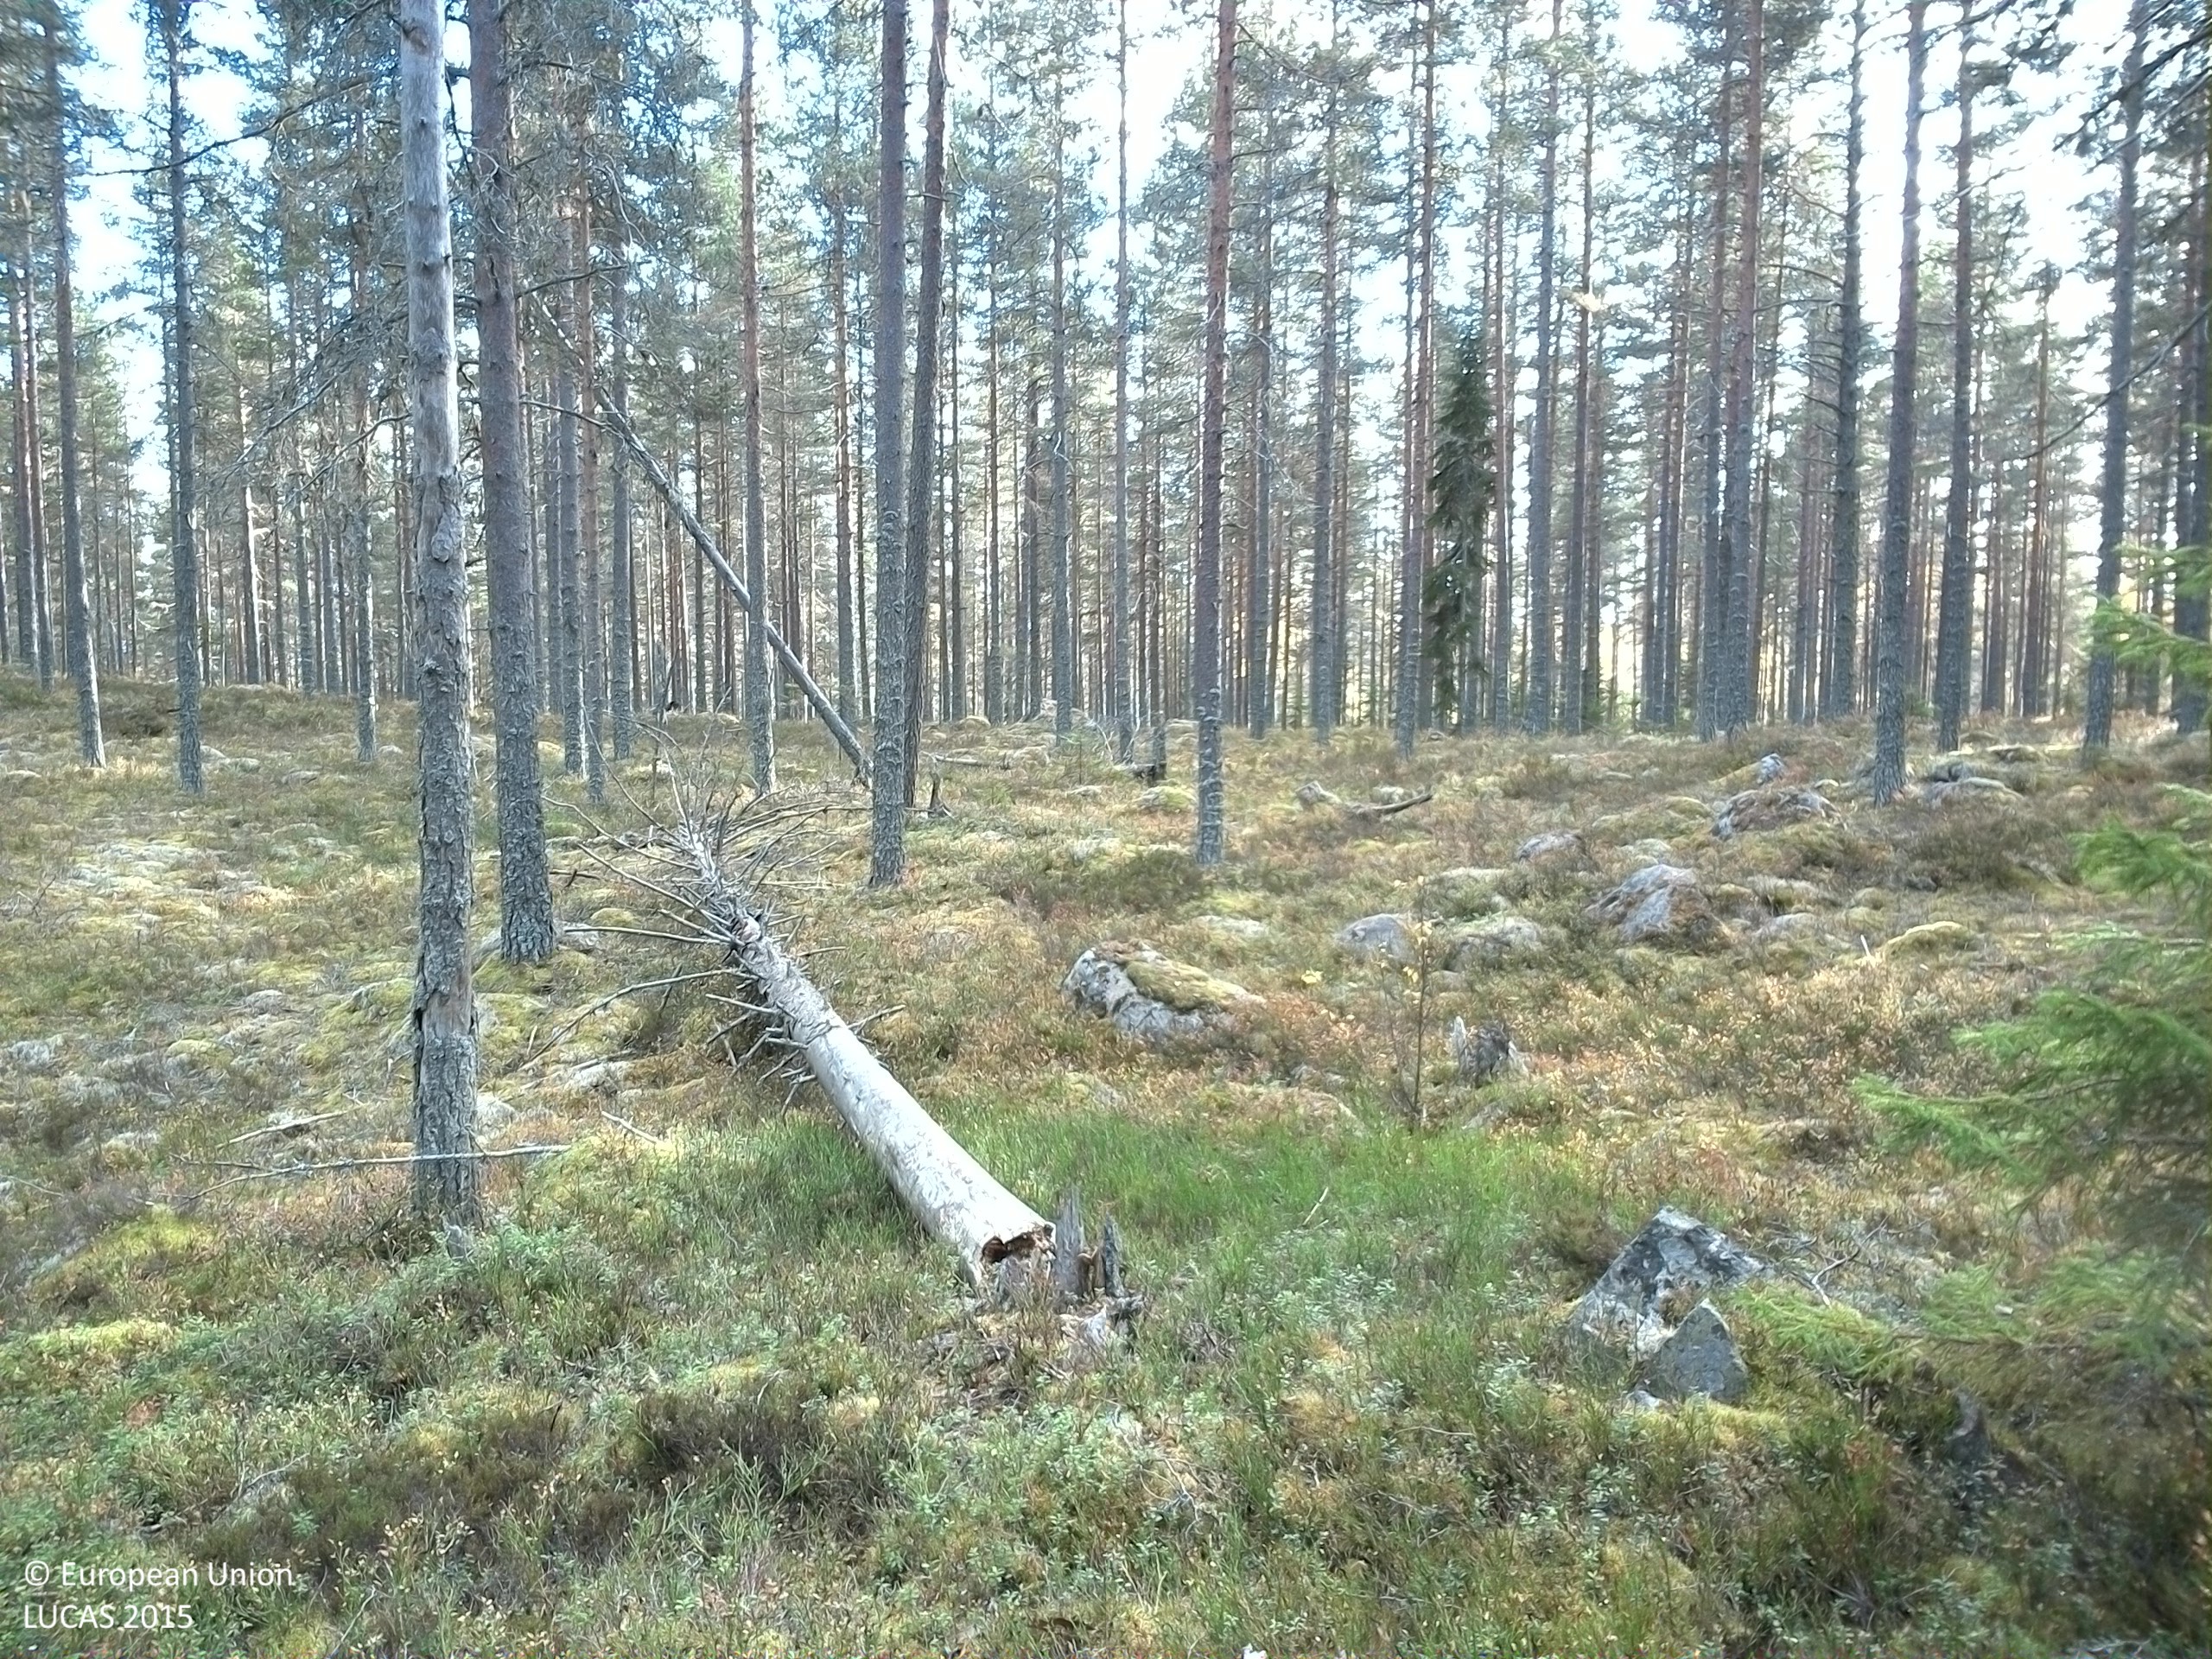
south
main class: Woodland
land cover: Pine dominated coniferous woodland
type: boreal forest
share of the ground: 50 - 75 %
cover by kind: coniferous forest trees 50 %, shrubs 25 %, lichens and mosses 15 %, consolidated bare surface 10 %
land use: Forestry
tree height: > 5 m
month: October
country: SE
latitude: 61.2830
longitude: 15.0039
